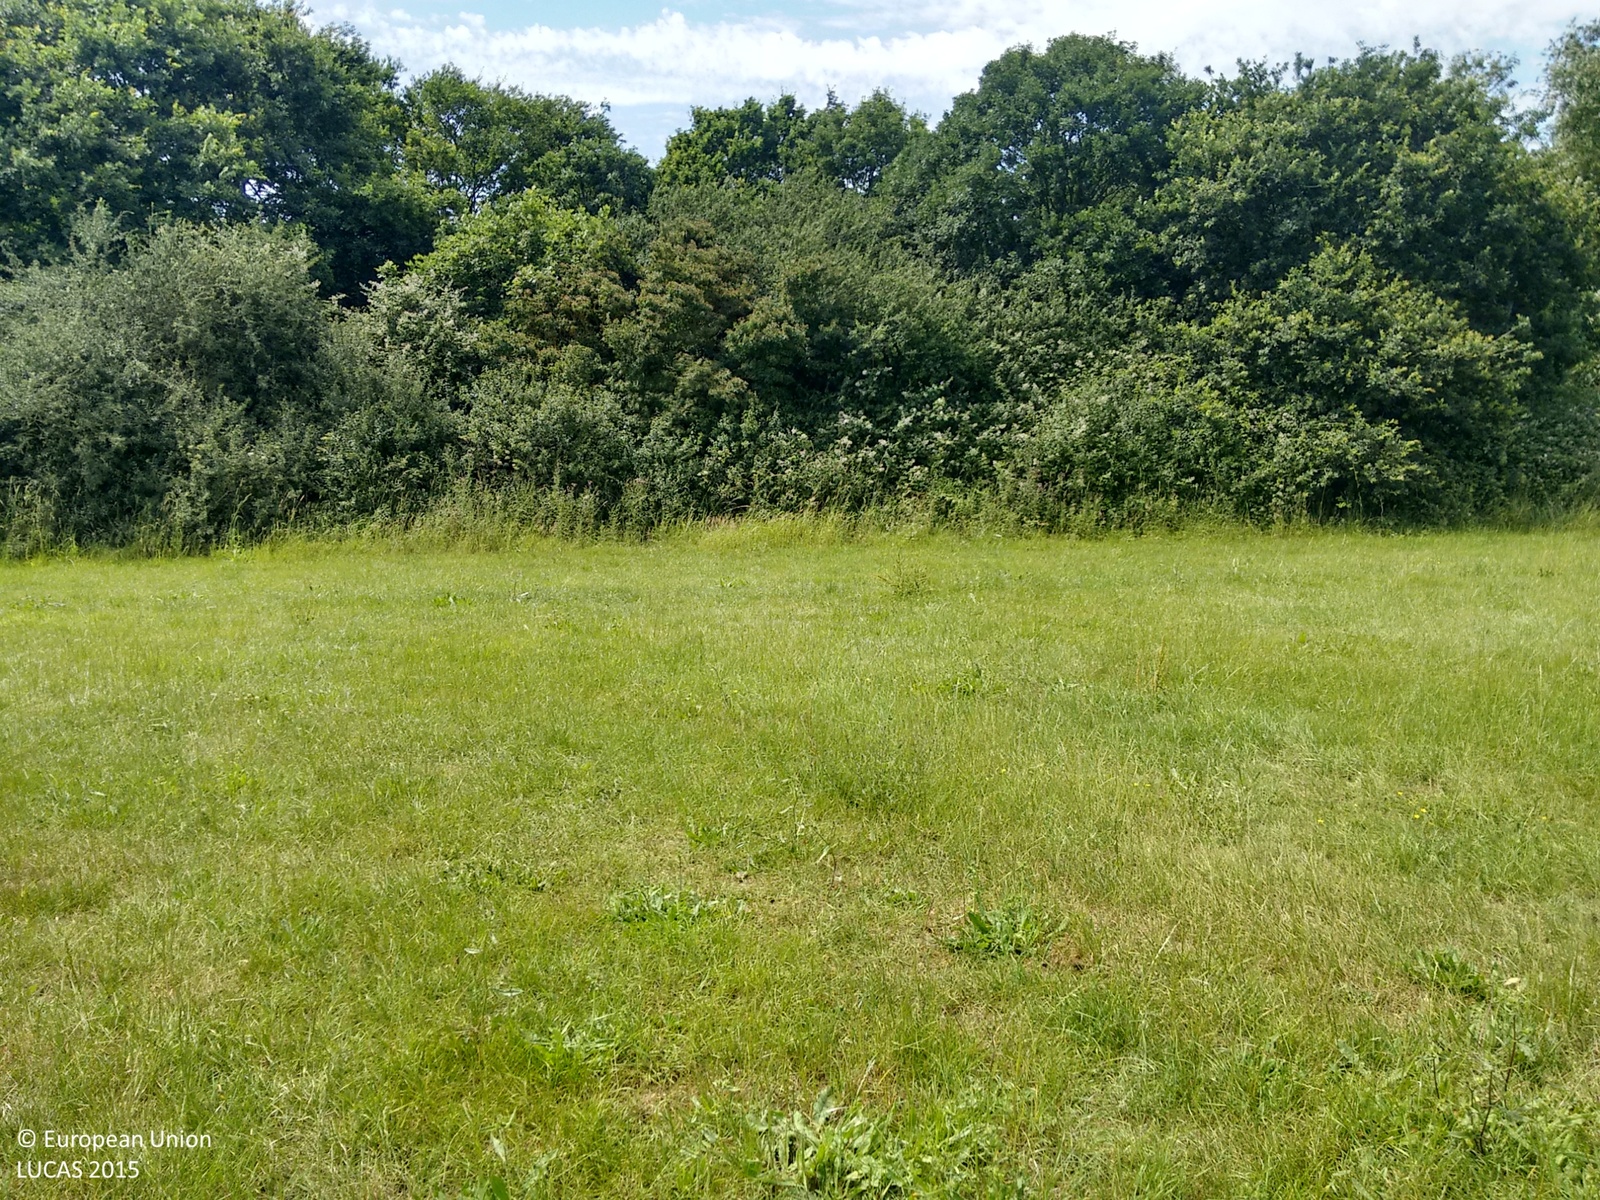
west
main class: Grassland
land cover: Grassland without tree/shrub cover
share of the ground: > 75 %
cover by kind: herbaceous plants 100 %
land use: Sport
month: July
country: GB
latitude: 51.5832
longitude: 0.5486
